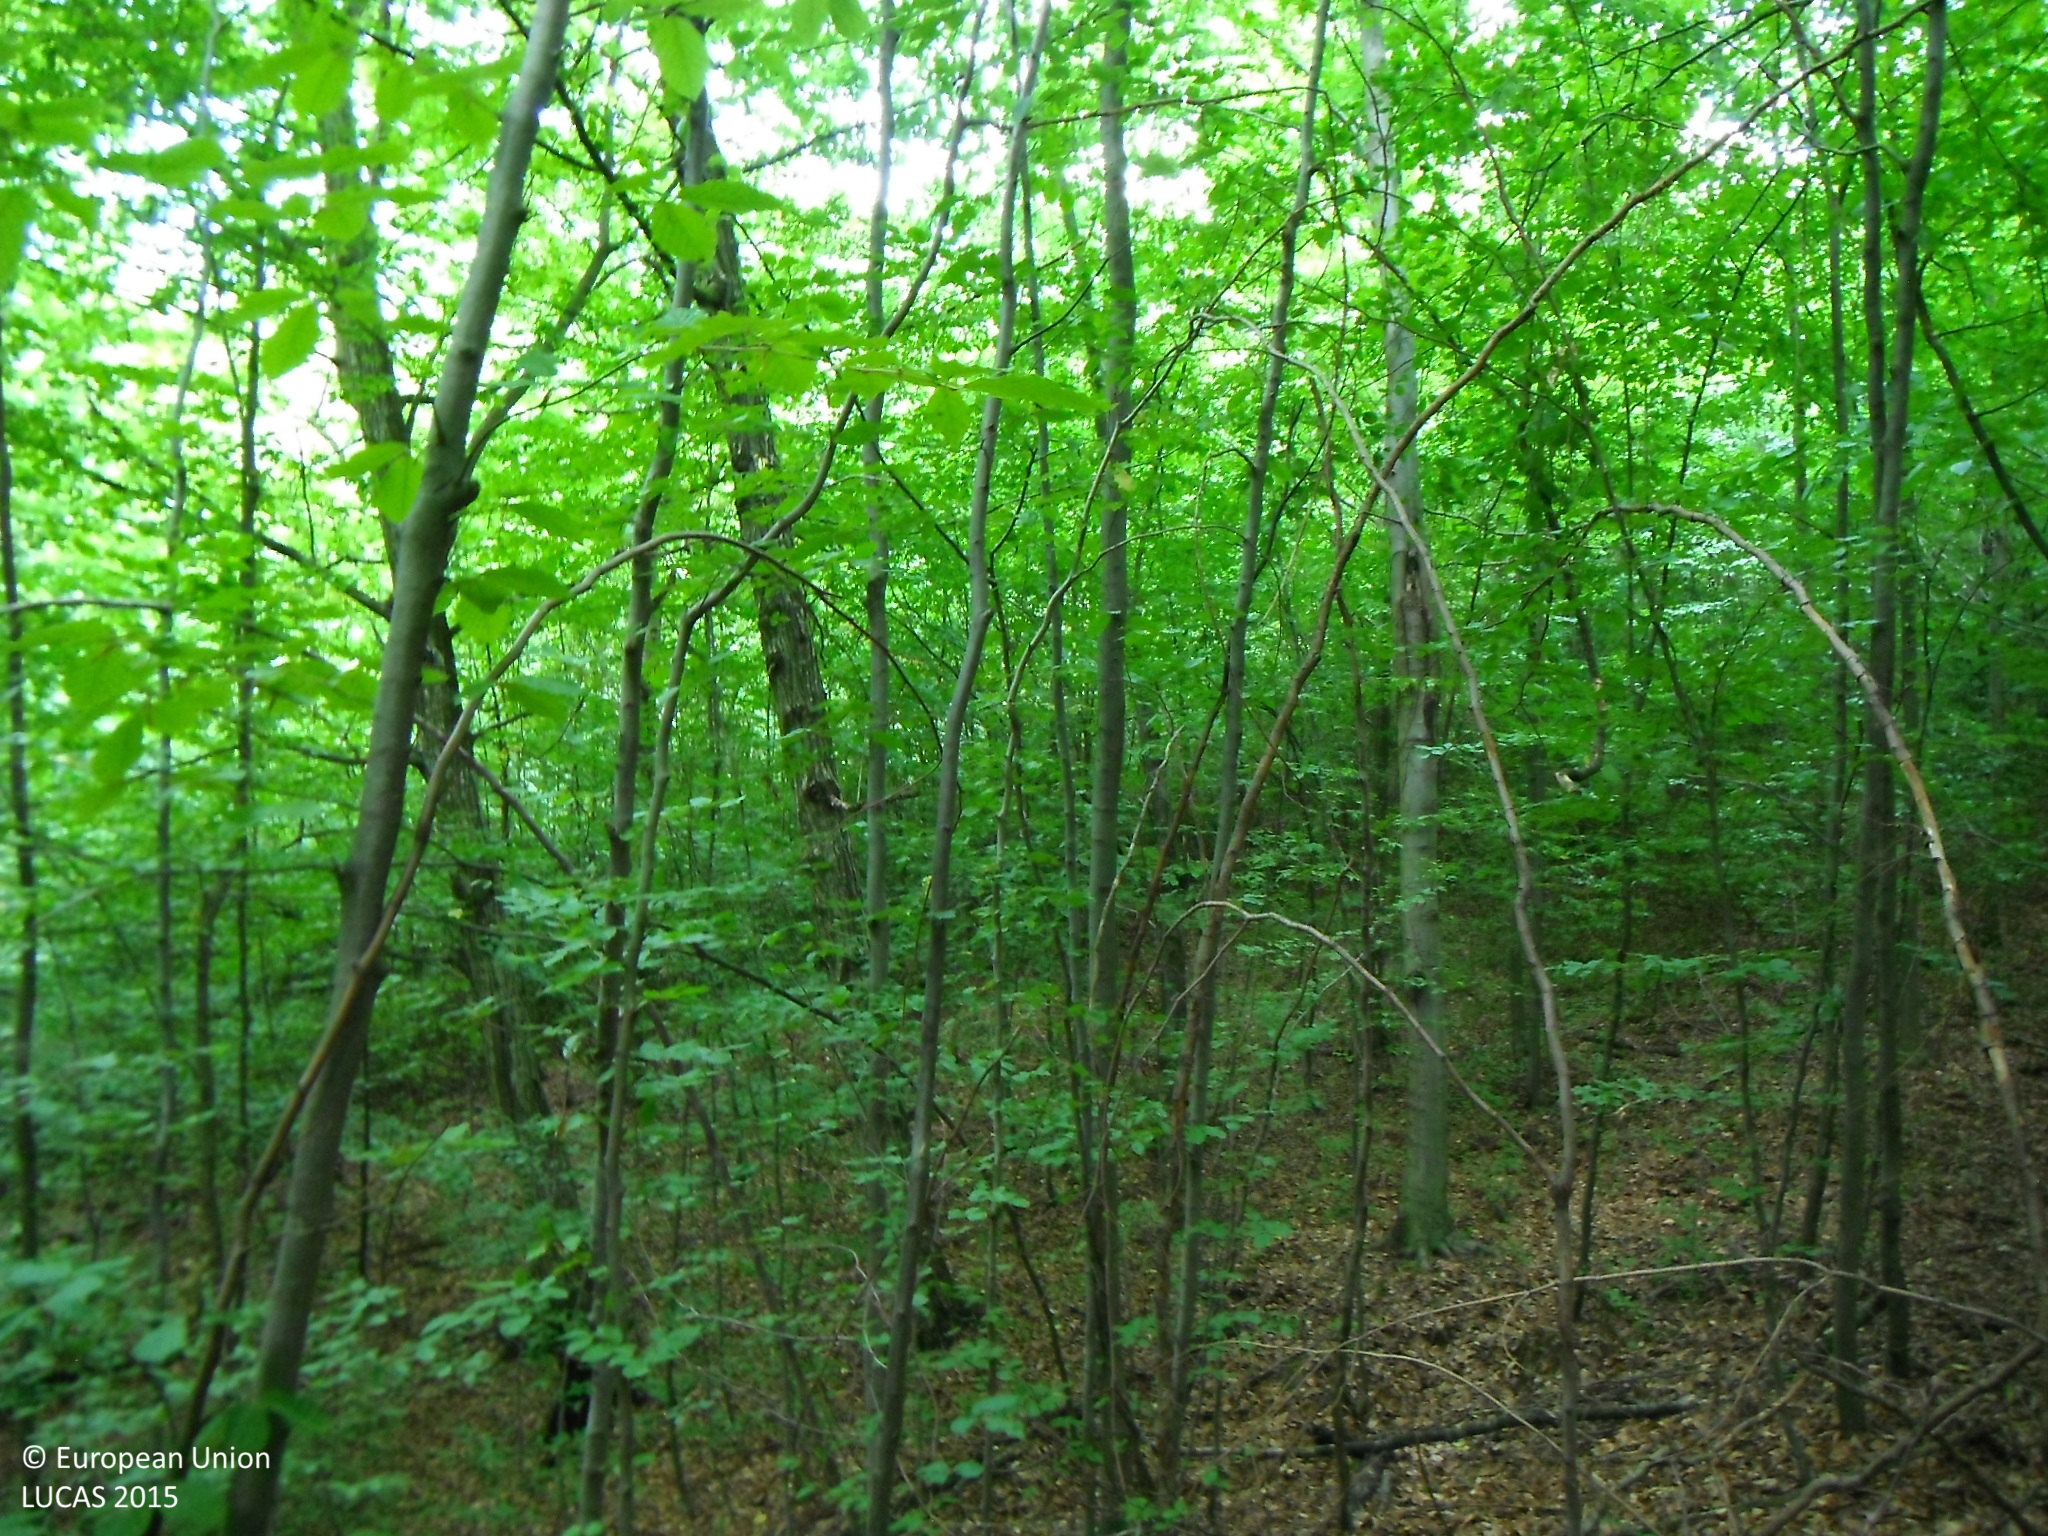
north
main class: Woodland
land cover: Broadleaved woodland
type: beech forest
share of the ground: > 75 %
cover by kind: broadleaved forest trees 100 %
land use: Forestry
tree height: > 5 m
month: July
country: SK
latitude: 49.3124
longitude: 21.6468
